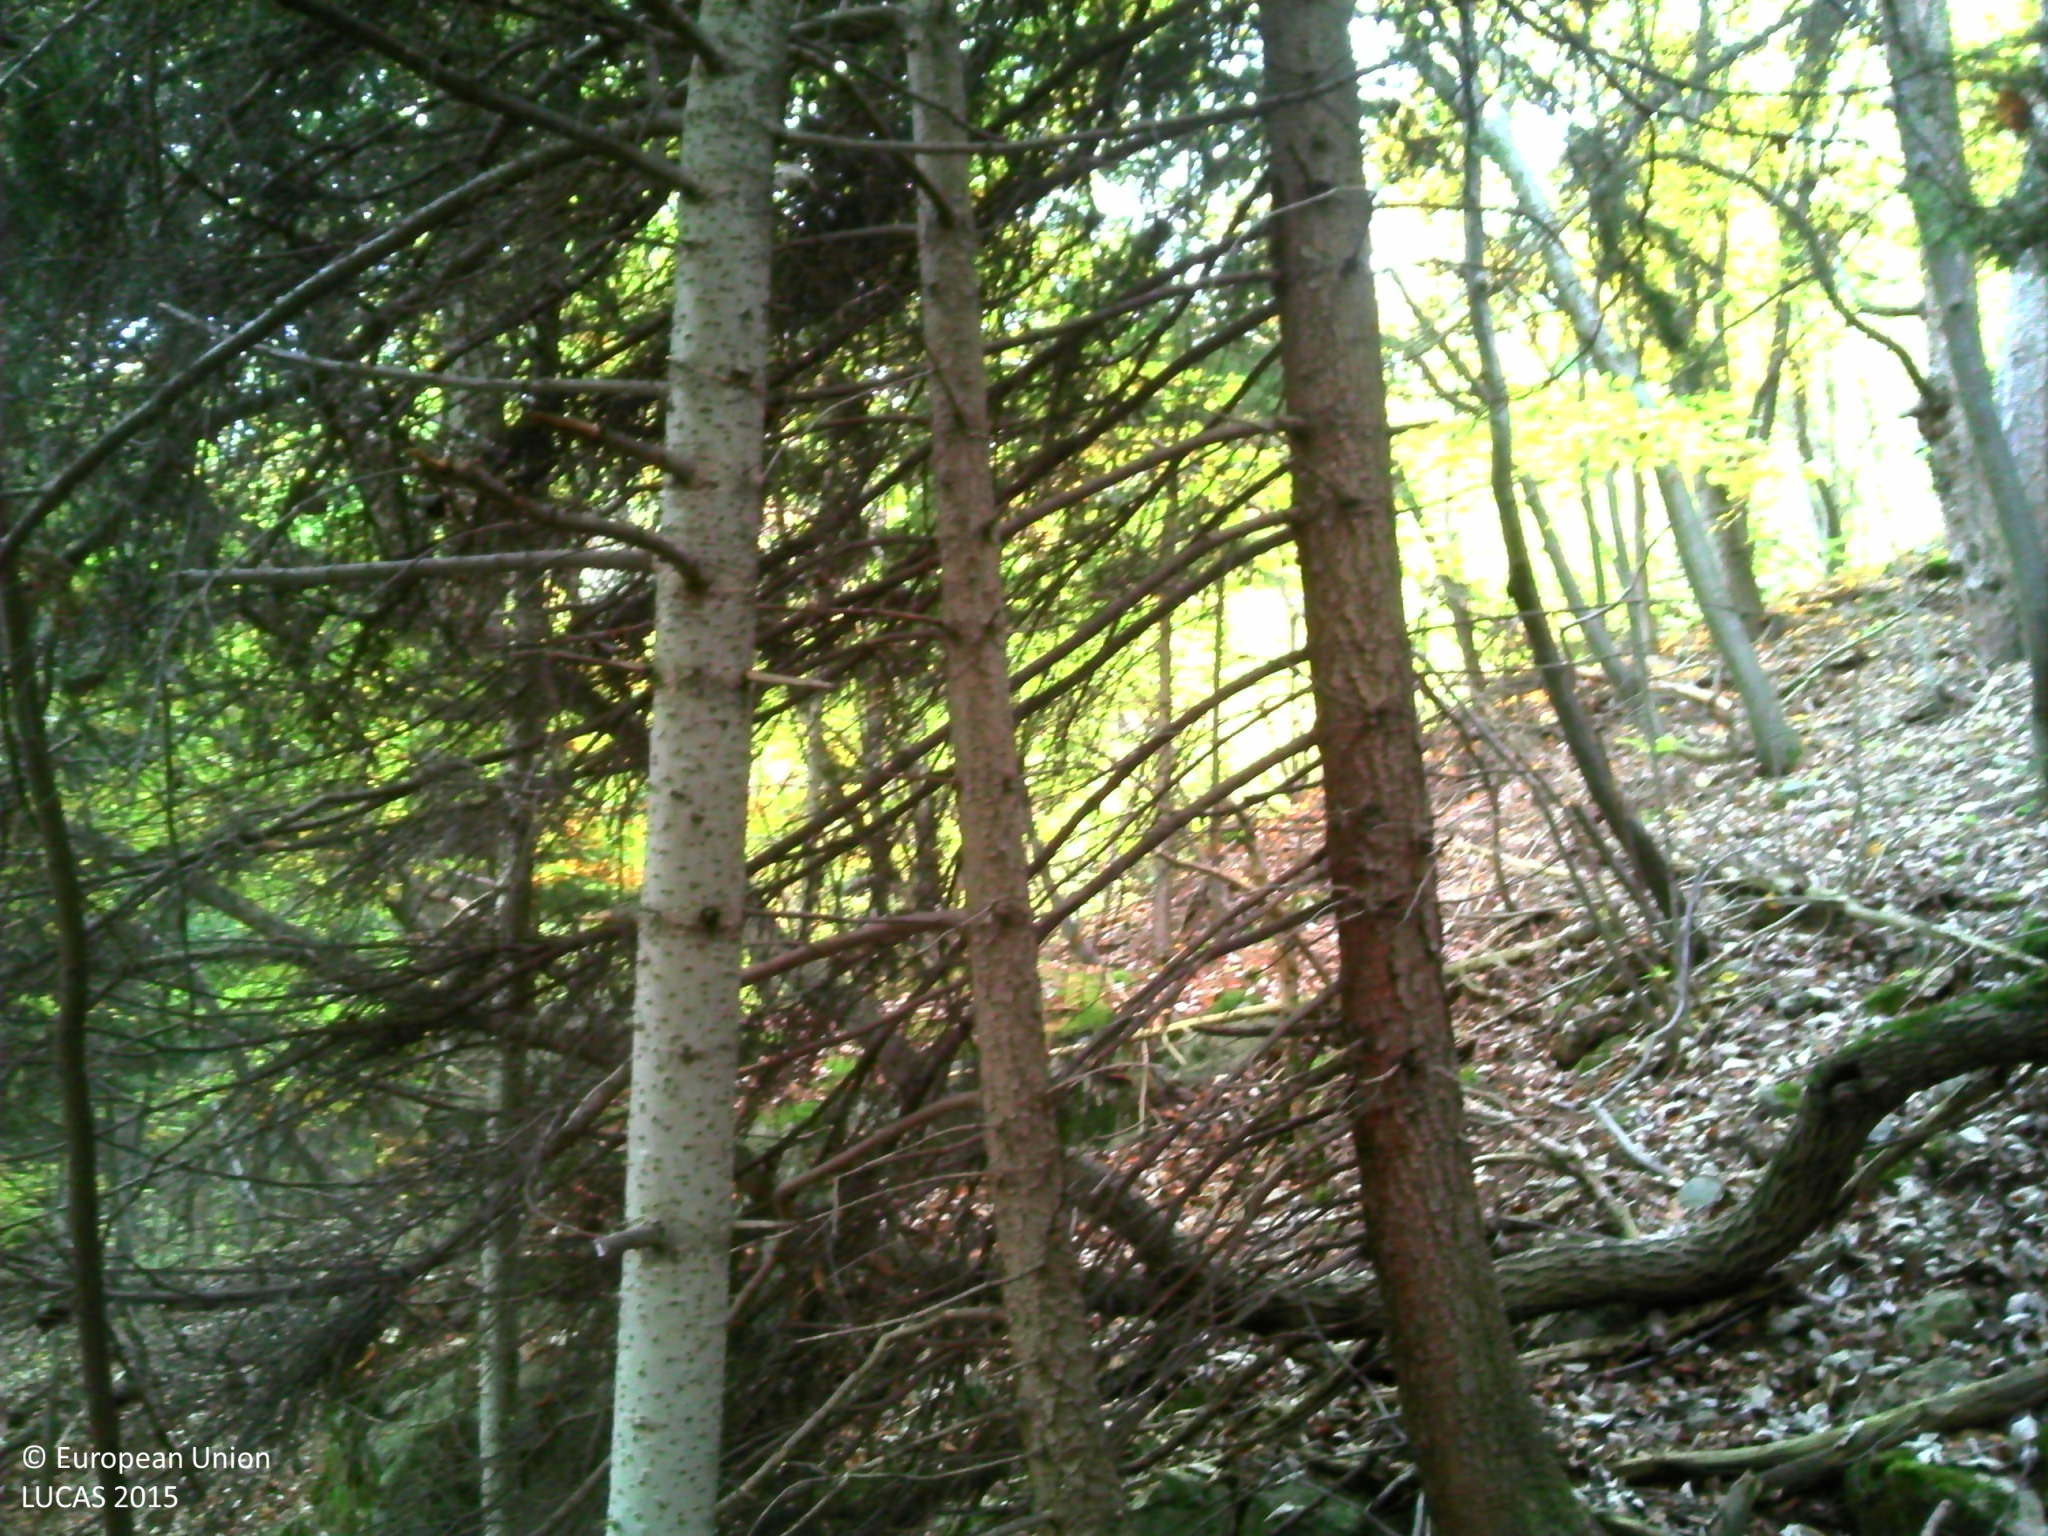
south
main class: Woodland
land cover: Spruce dominated mixed woodland
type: hemiboreal forest and nemoral coniferous forest and mixed broadleaved-coniferous forest
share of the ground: > 75 %
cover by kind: coniferous forest trees 50 %, broadleaved forest trees 40 %, unconsolidated bare surface 10 %
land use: Forestry
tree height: > 5 m
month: October
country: FR
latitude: 45.2103
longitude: 6.4527
